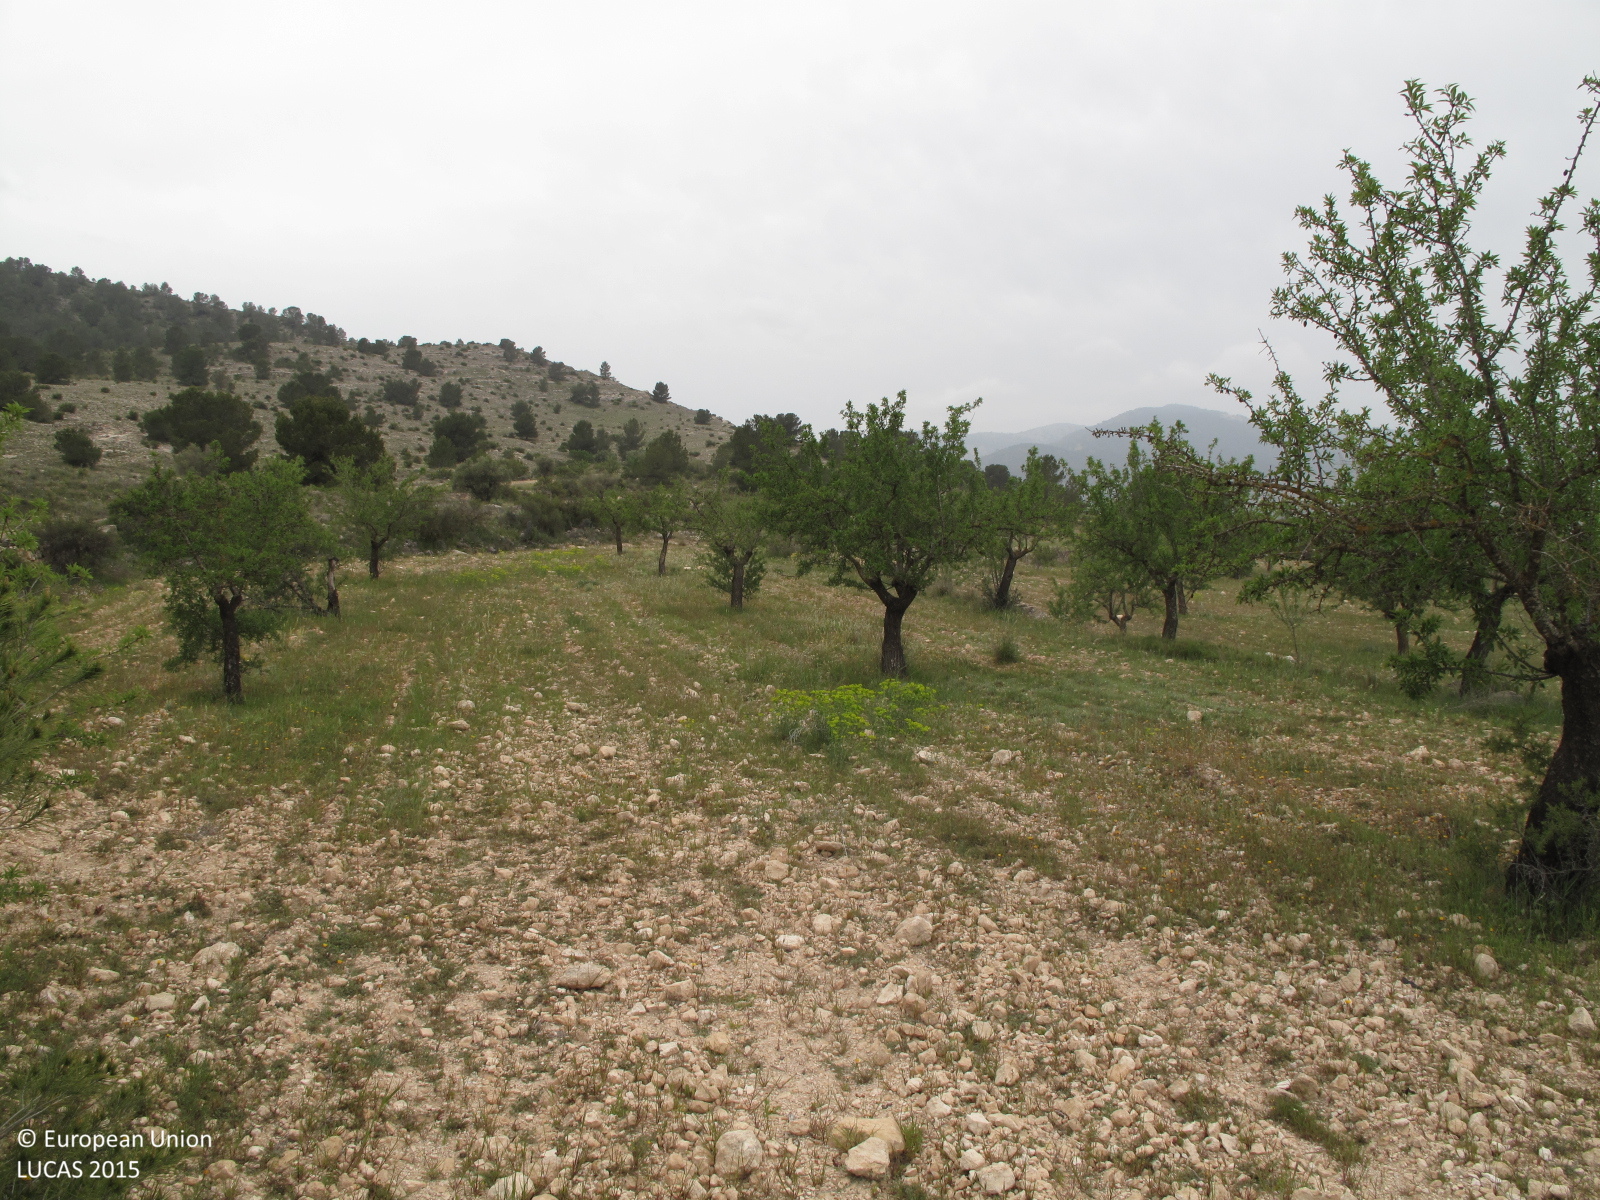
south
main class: Cropland
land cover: Nuts trees
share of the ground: < 10 %
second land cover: Spontaneously vegetated surfaces
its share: > 75 %
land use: Agriculture (excluding fallow land and kitchen gardens)
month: April
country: ES
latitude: 38.4344
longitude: -0.9057
